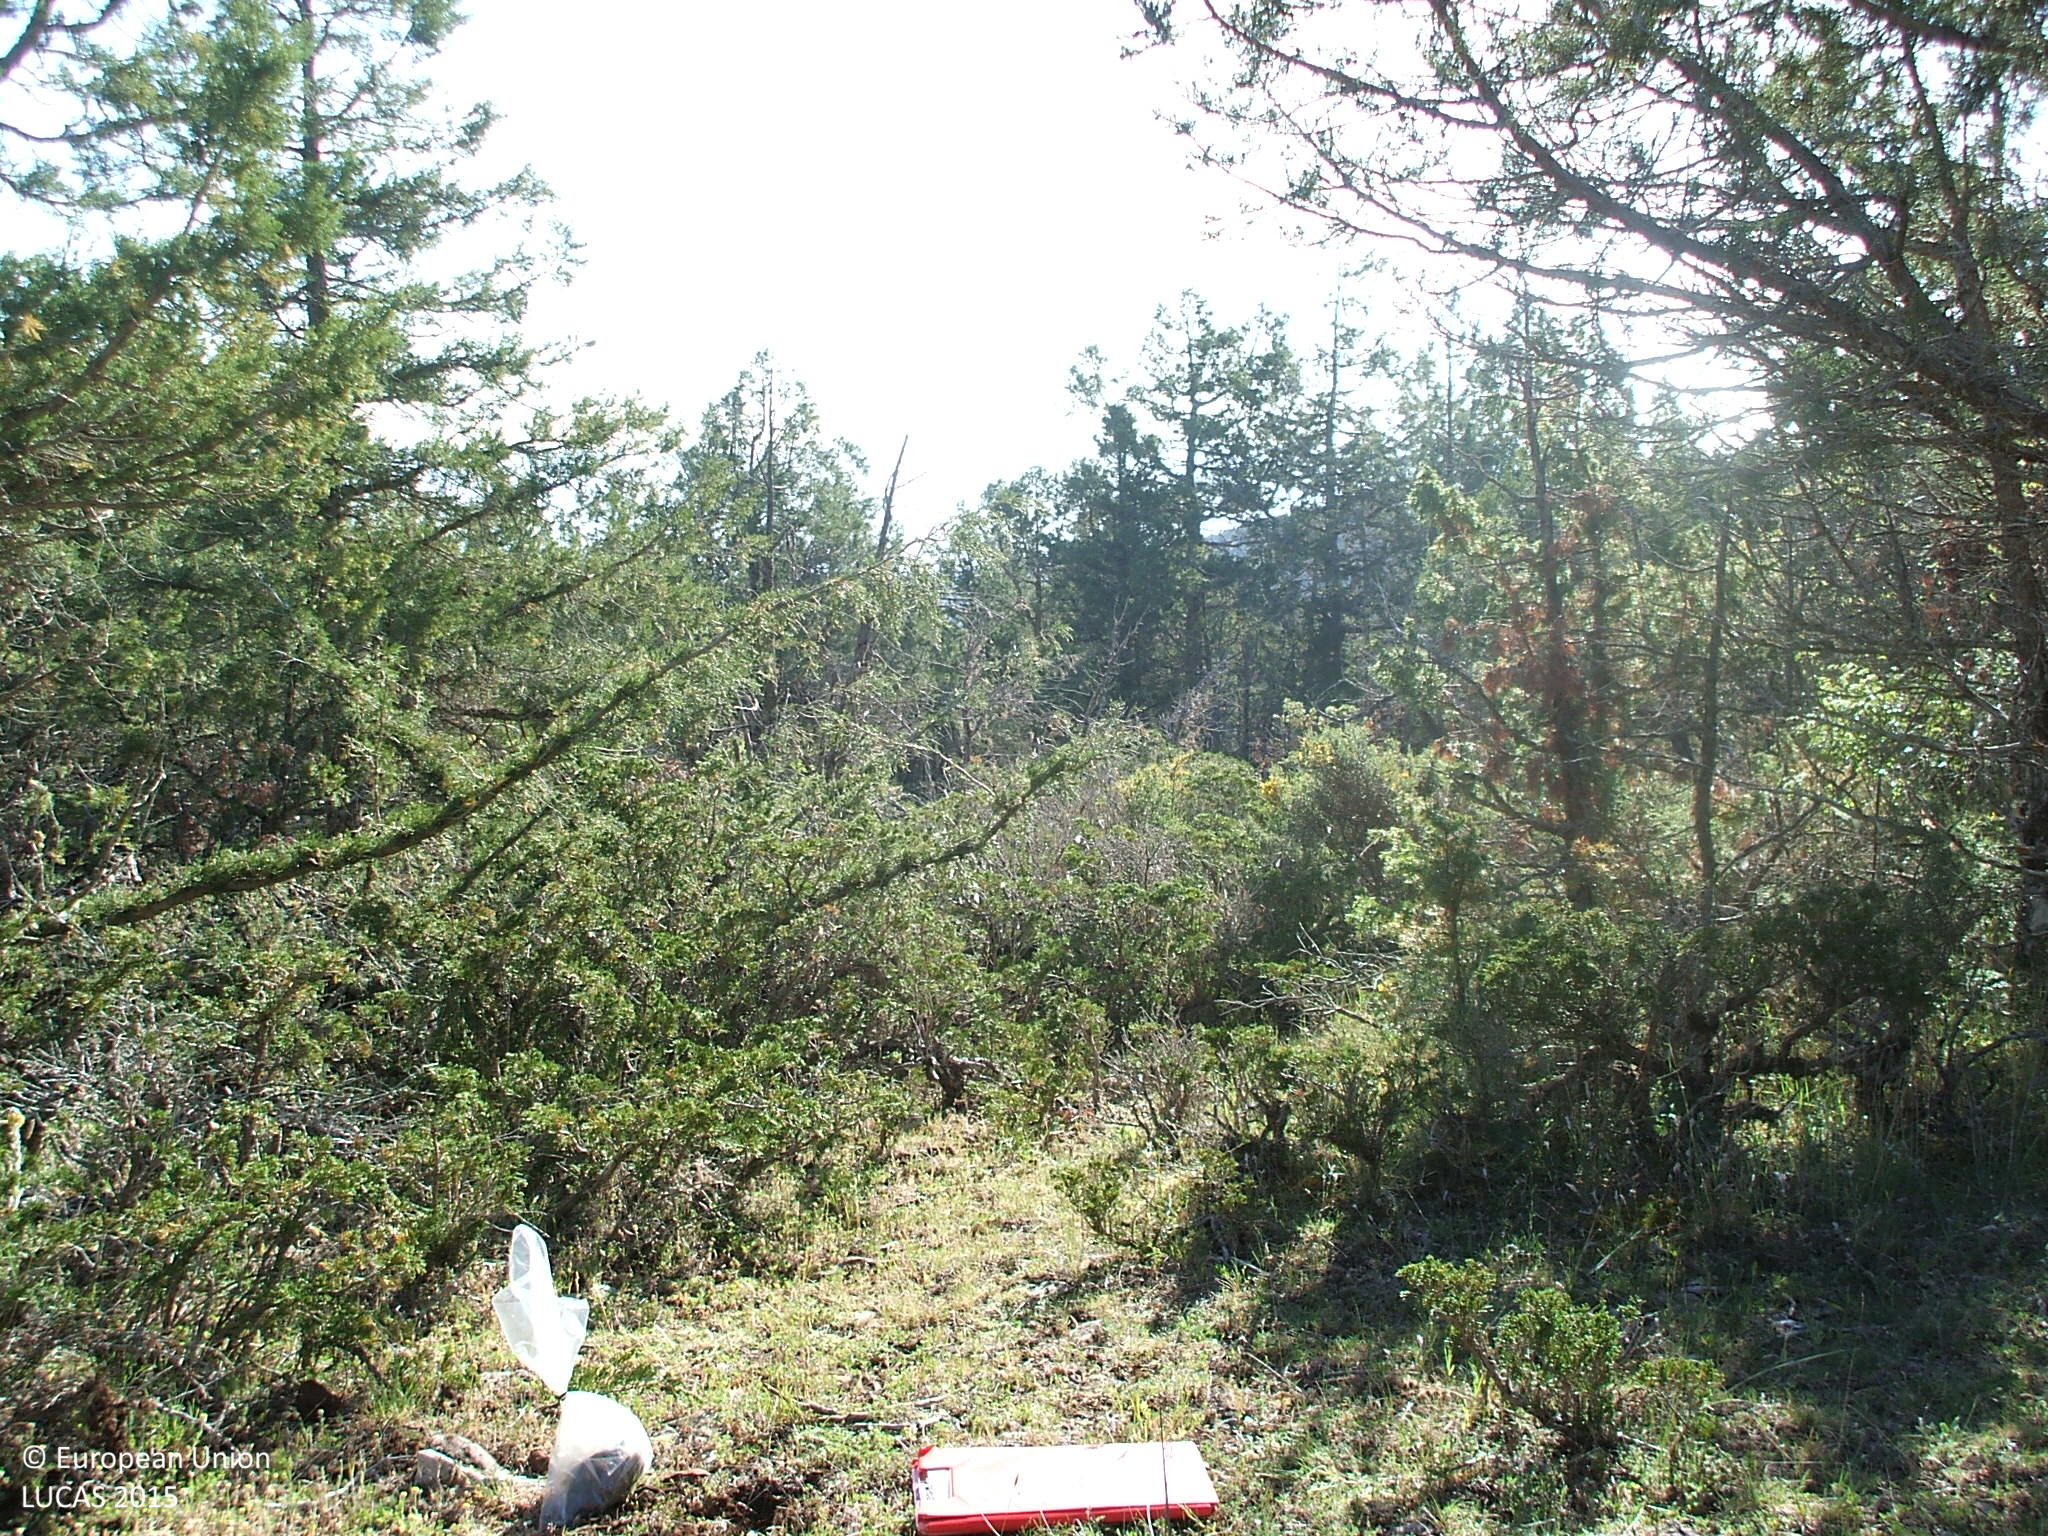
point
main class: Woodland
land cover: Other coniferous woodland
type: coniferous forest of the mediterranean region
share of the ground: 50 - 75 %
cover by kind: coniferous forest trees 60 %, herbaceous plants 40 %
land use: Semi-natural and natural areas not in use
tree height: > 5 m
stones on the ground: > 50 %
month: May
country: ES
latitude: 40.1440
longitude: -0.9591
